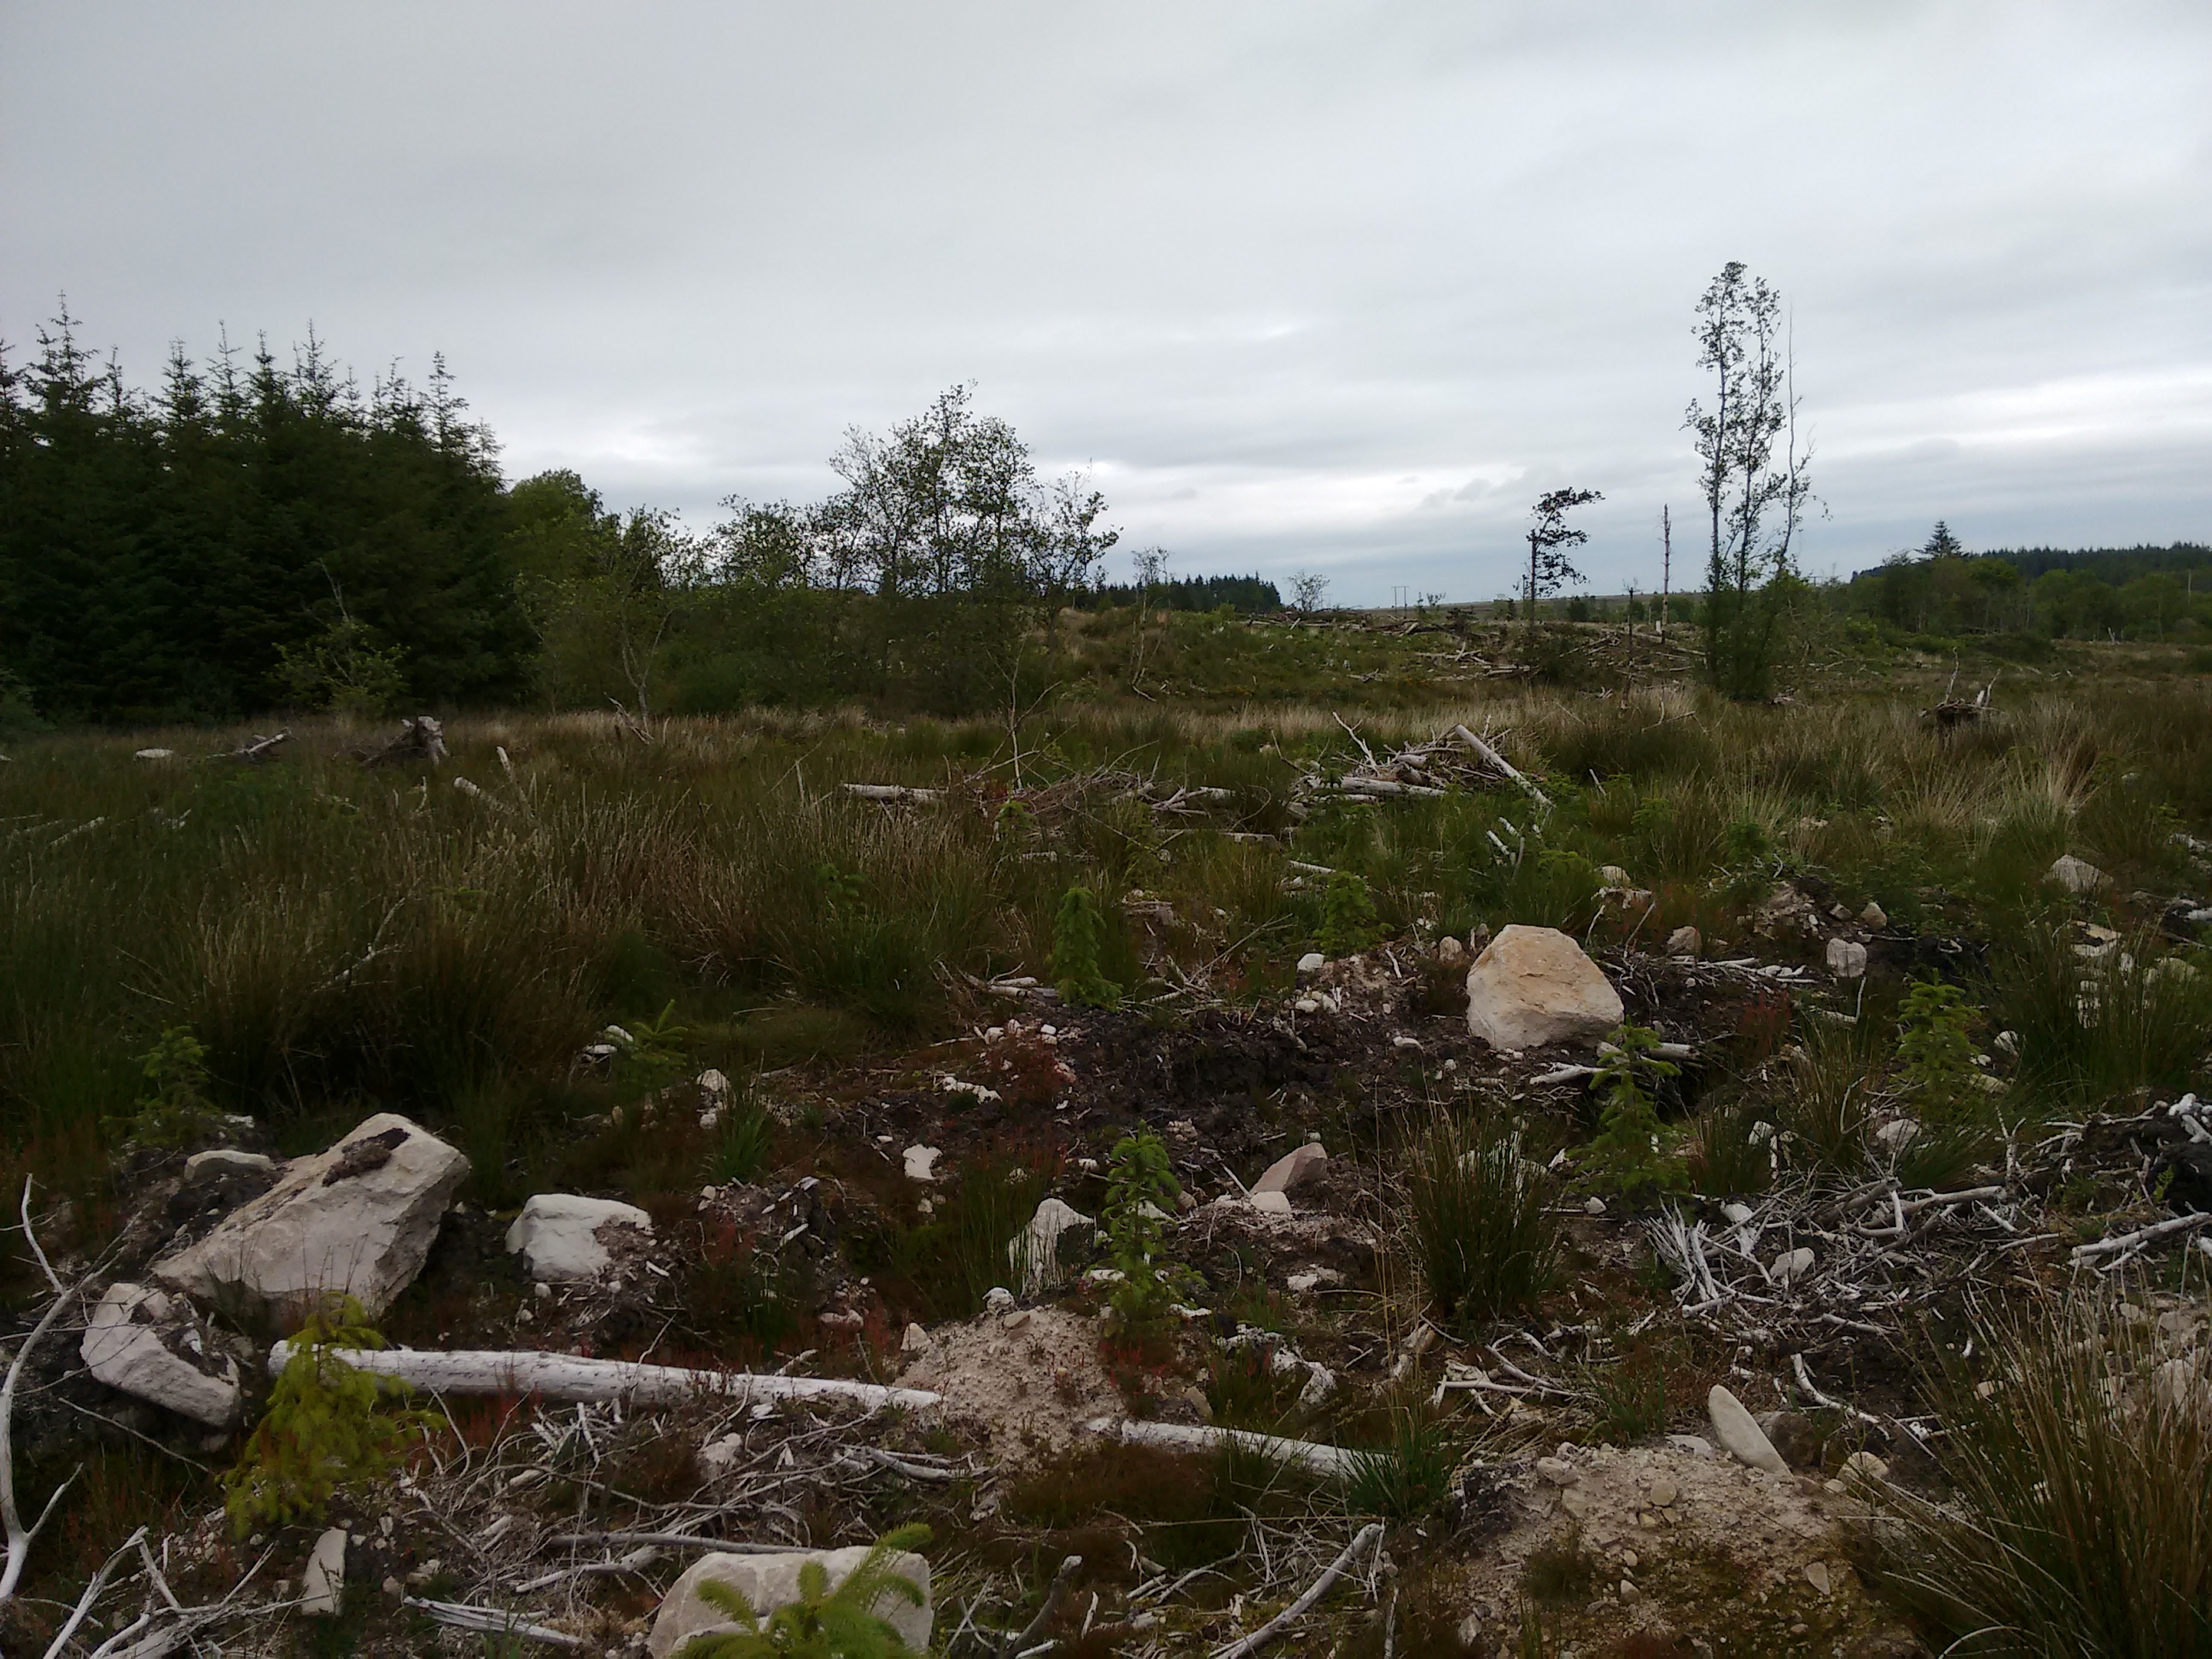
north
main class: Grassland
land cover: Grassland with sparse tree/shrub cover
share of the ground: > 75 %
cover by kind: herbaceous plants 35 %, lichens and mosses 10 %, broadleaved forest trees 5 %, shrubs 5 %
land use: Forestry
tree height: < 5 m
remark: Clear cut
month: June
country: IE
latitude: 53.0483
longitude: -8.4971
